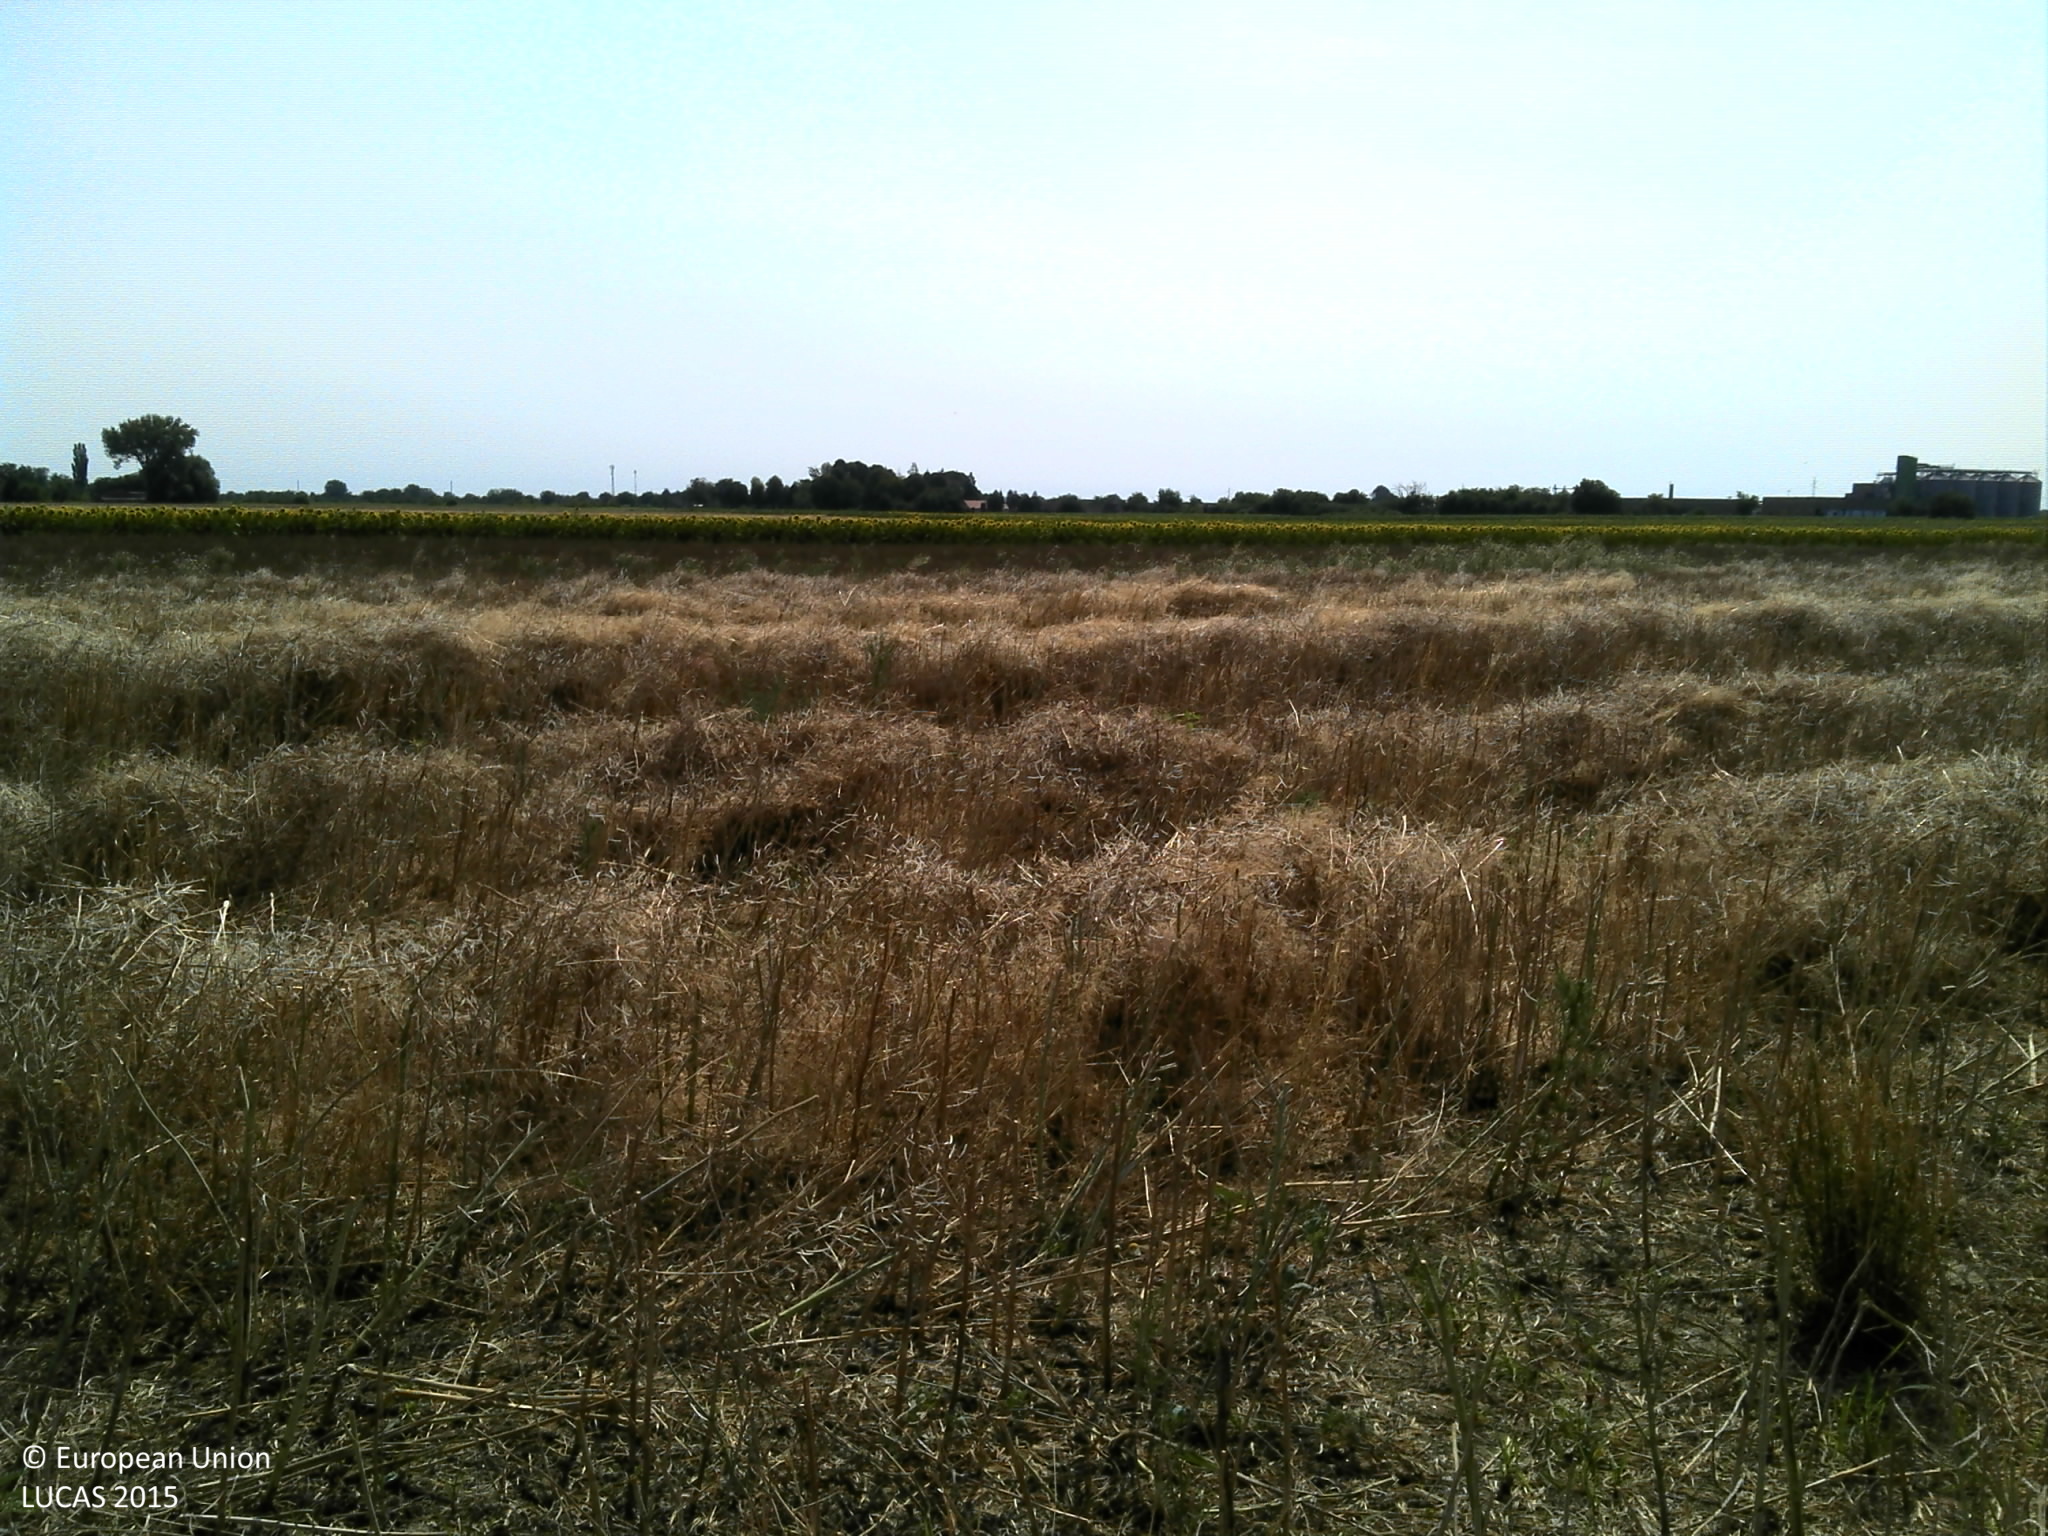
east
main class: Cropland
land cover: Rape and turnip rape
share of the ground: > 75 %
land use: Agriculture (excluding fallow land and kitchen gardens)
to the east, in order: Rape and turnip rape; Spontaneously vegetated surfaces; Sunflower; Grass margins; Sunflower; Maize; Common wheat; Rye; Tracks; Sunflower
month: July
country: HR
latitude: 45.3587
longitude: 18.5206
